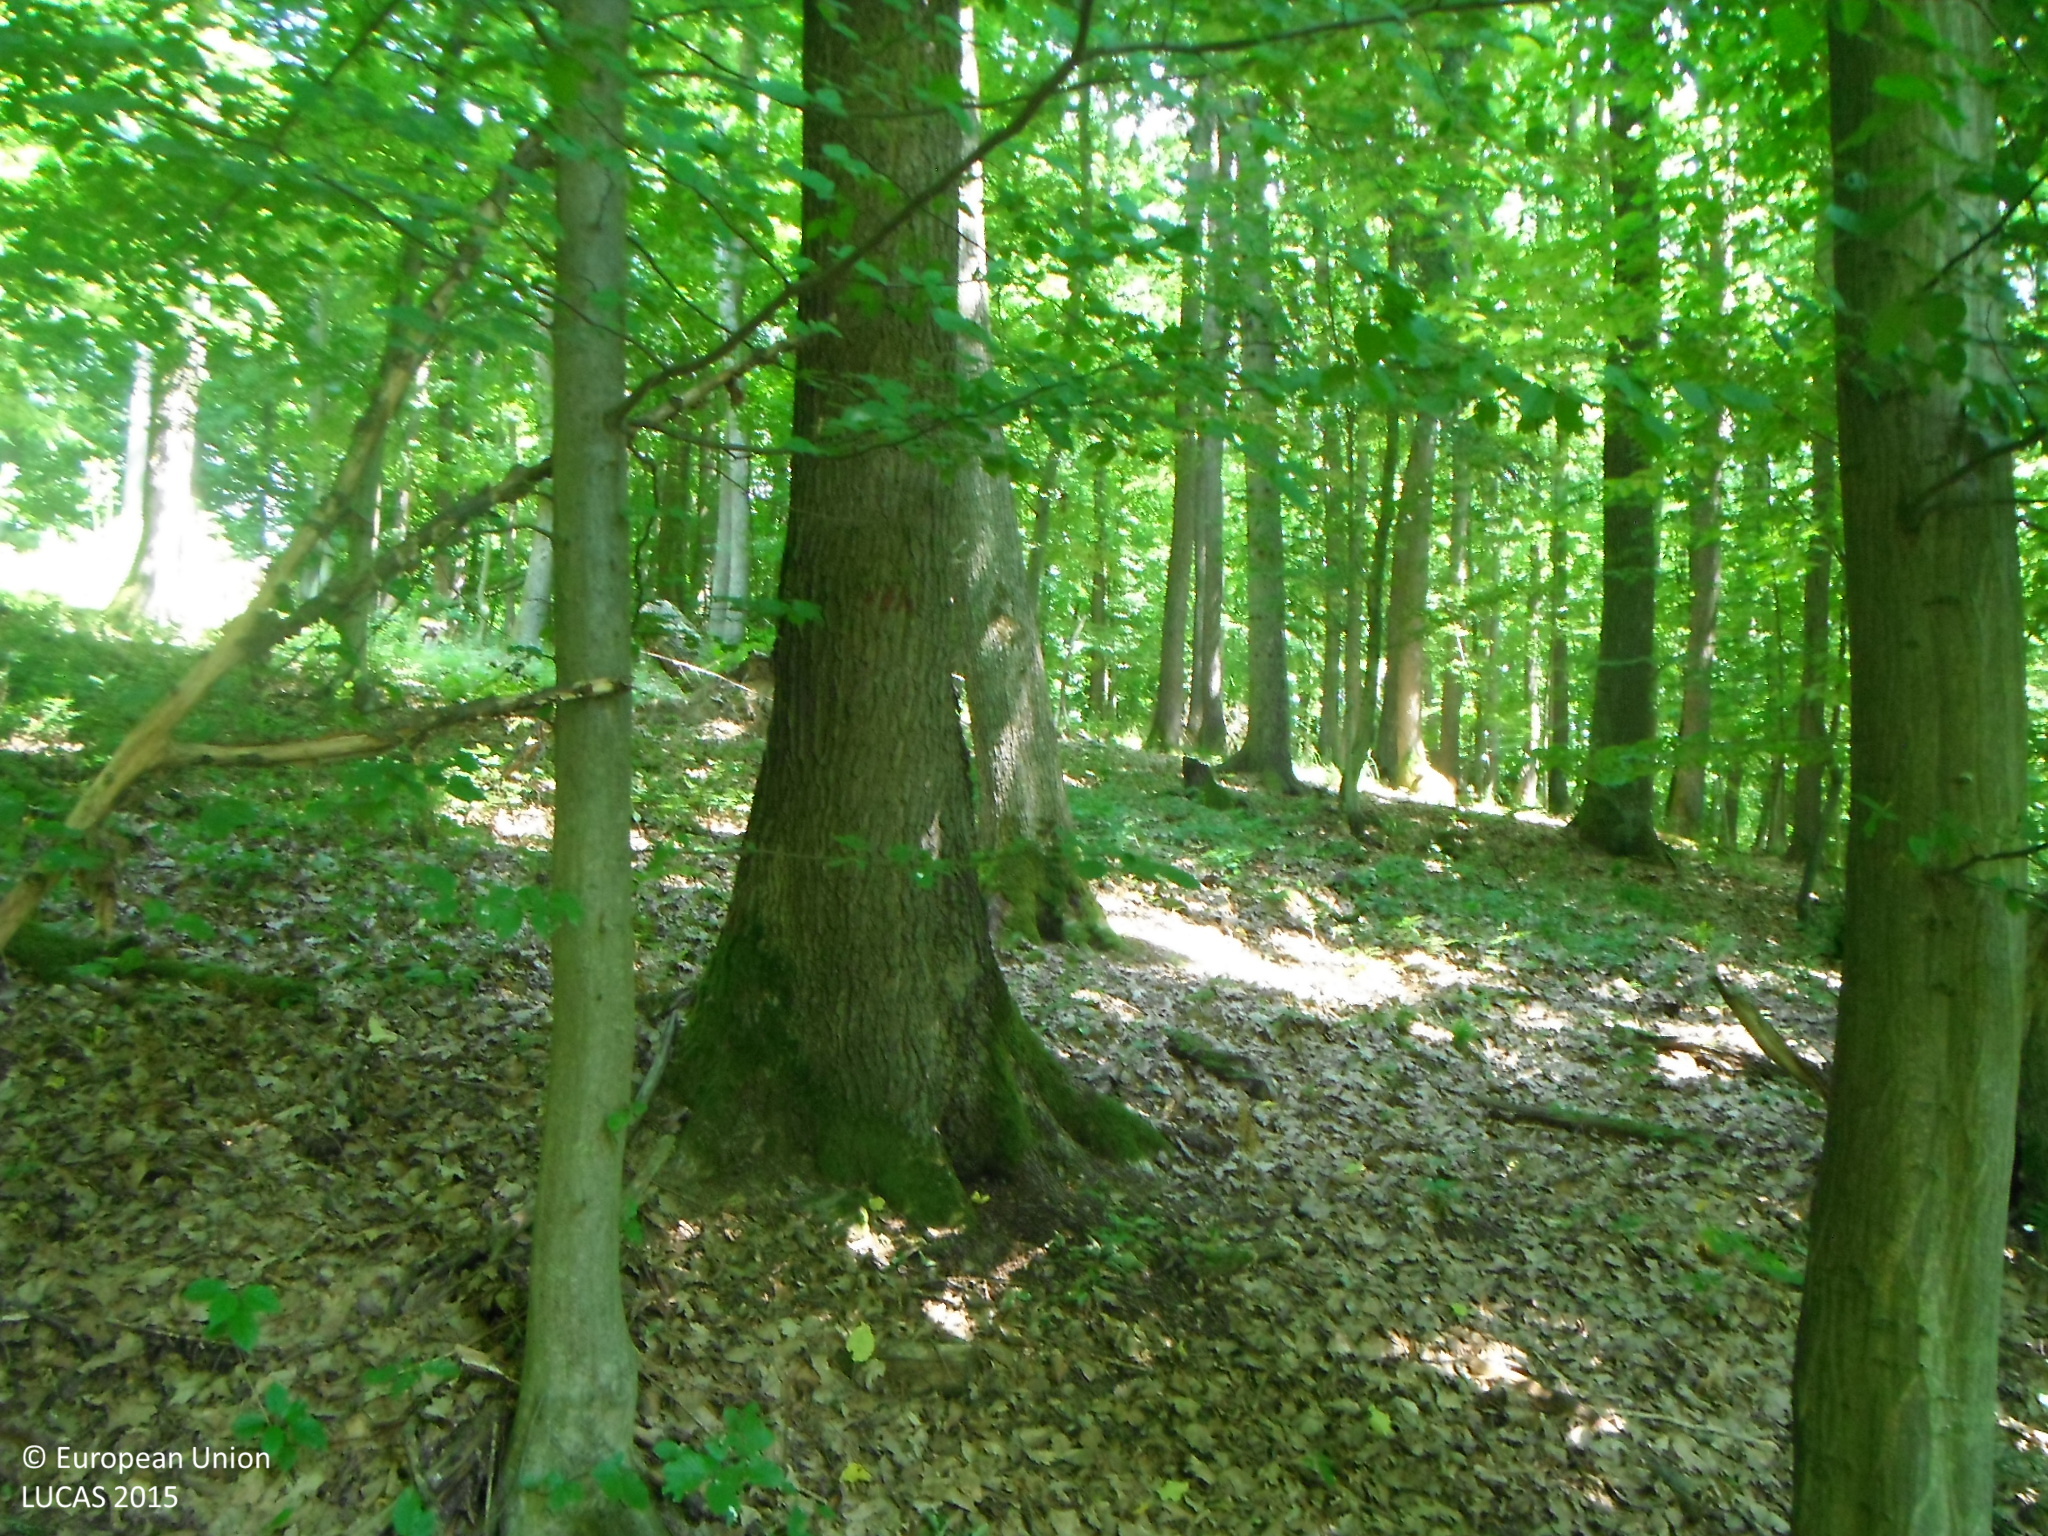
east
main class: Woodland
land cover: Broadleaved woodland
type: mesophytic deciduous forest
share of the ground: > 75 %
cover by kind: broadleaved forest trees 100 %
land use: Forestry
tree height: > 5 m
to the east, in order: Broadleaved woodland; Tracks; Broadleaved woodland; Tracks; Broadleaved woodland; Spruce dominated mixed woodland
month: June
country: SK
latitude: 48.6720
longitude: 19.1889
